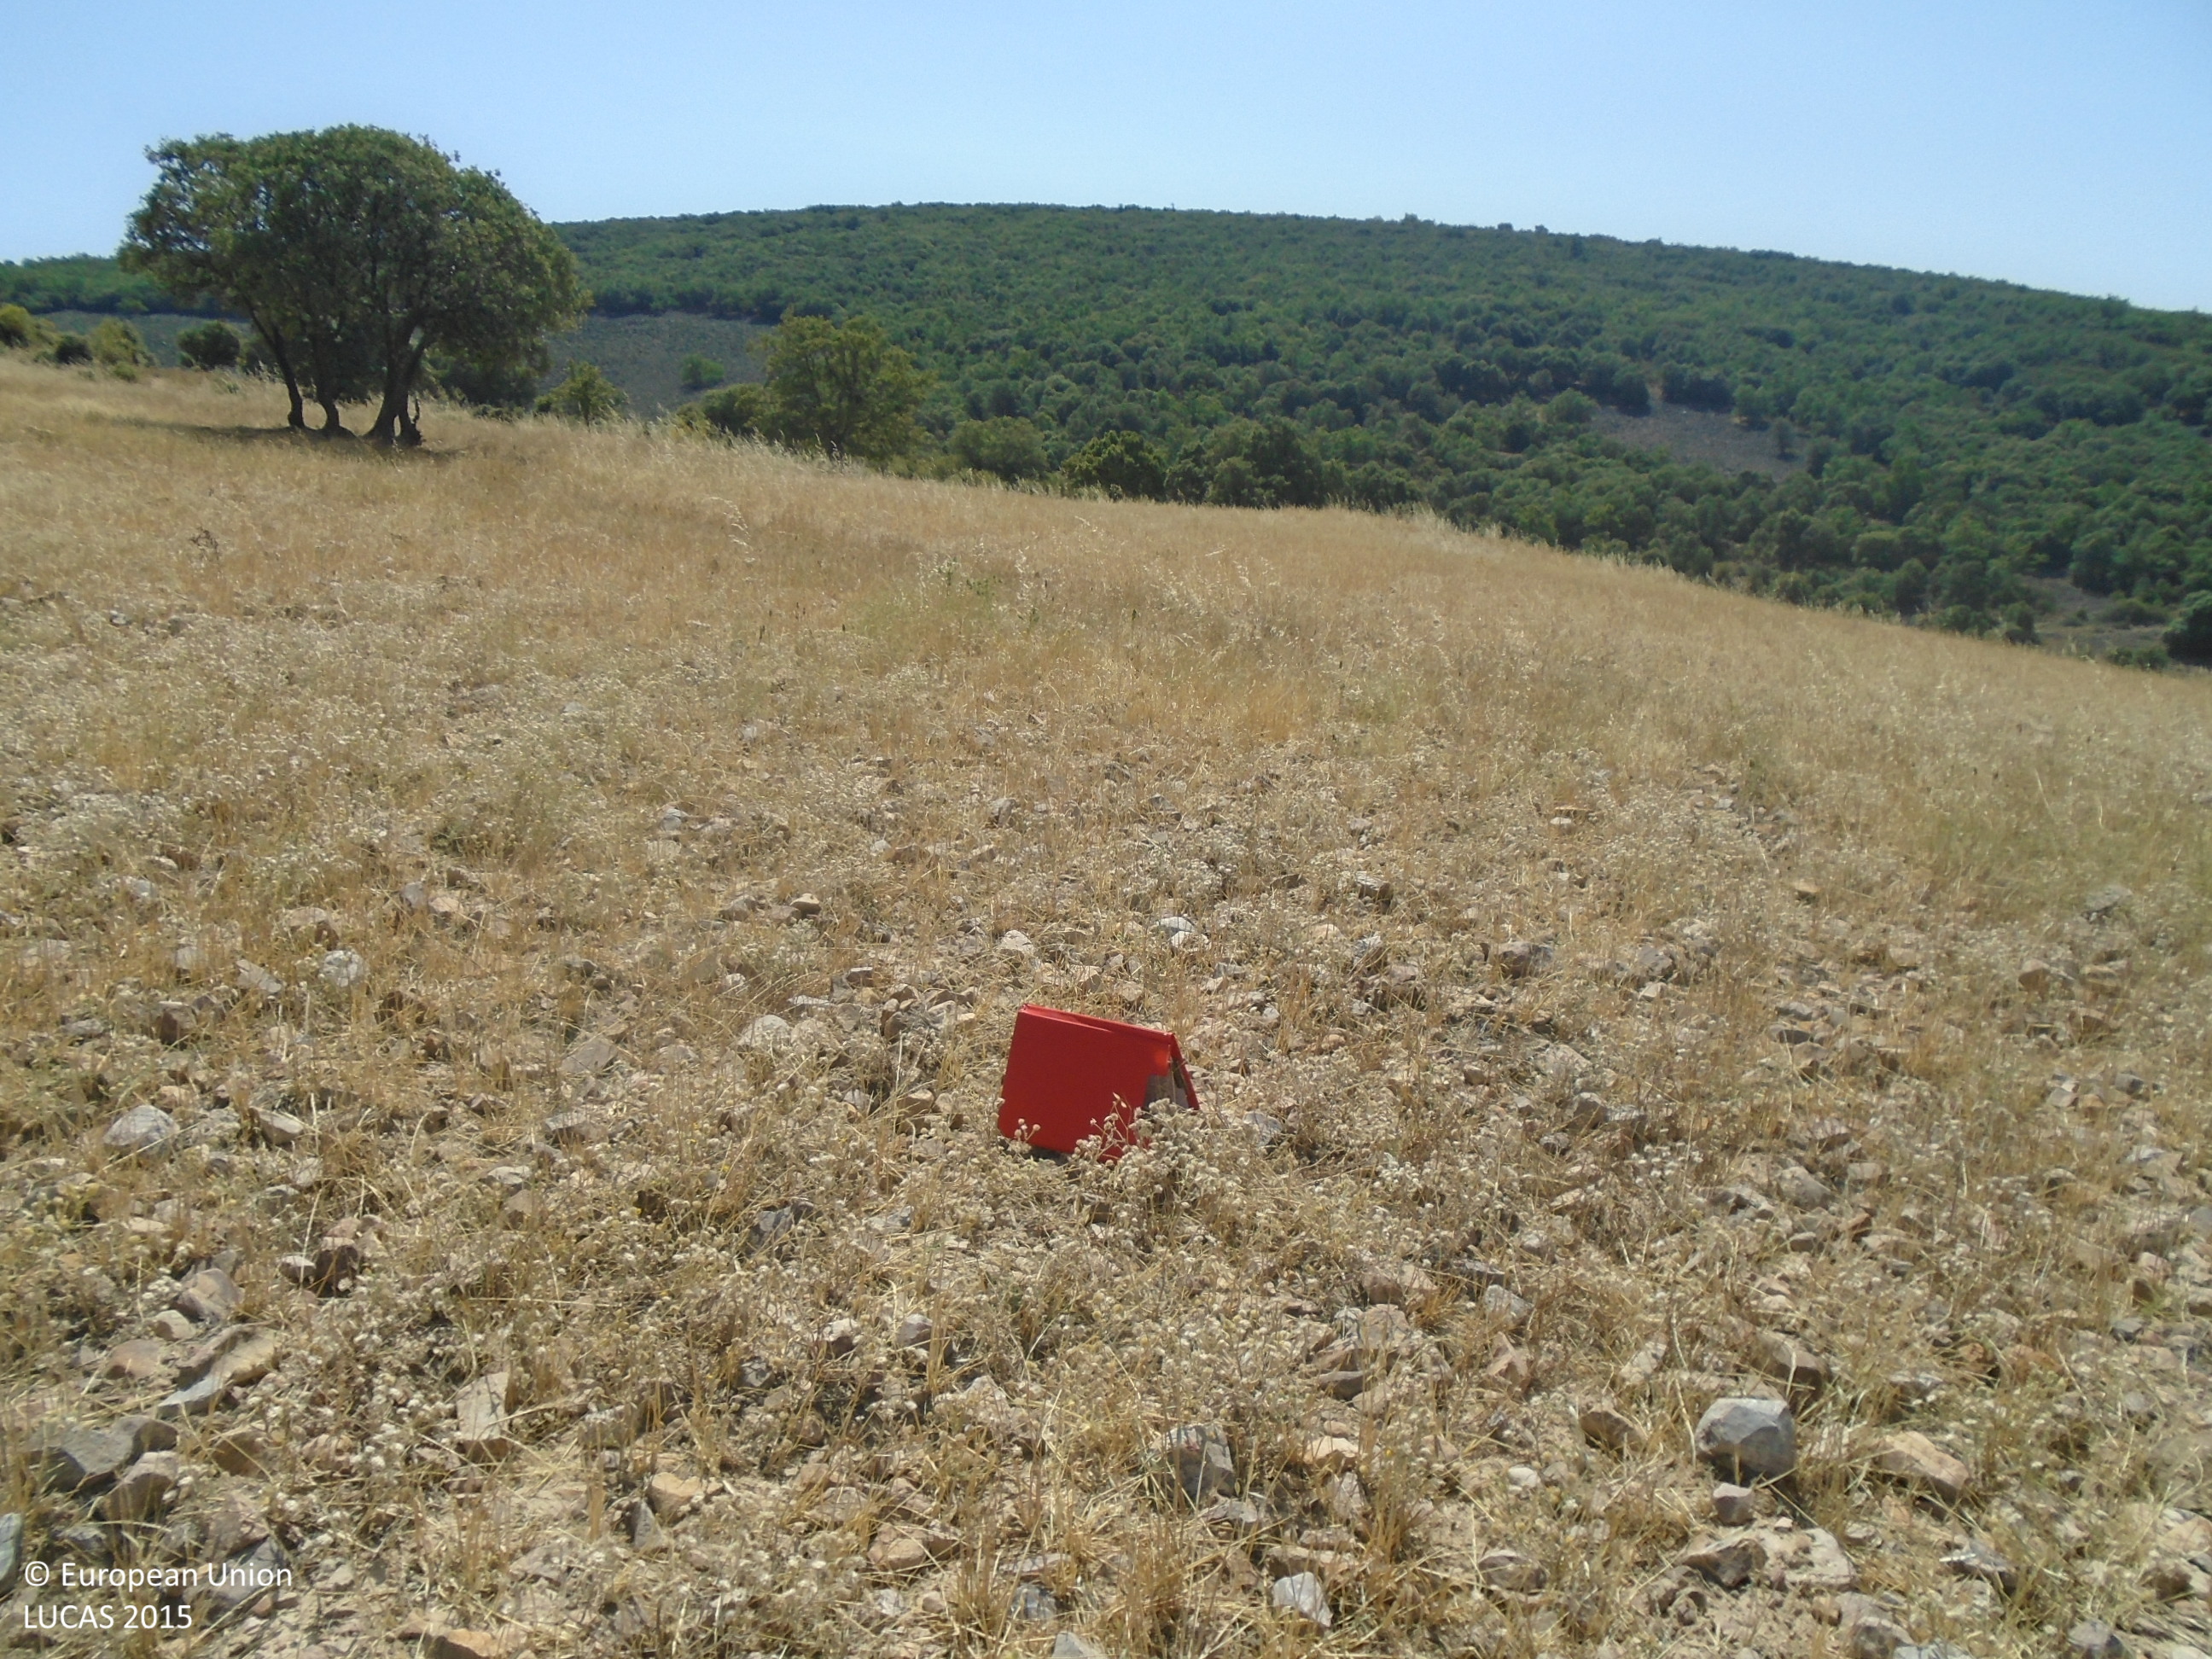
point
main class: Grassland
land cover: Spontaneously vegetated surfaces
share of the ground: > 75 %
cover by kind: herbaceous plants 80 %, consolidated bare surface 20 %
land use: Agriculture (excluding fallow land and kitchen gardens)
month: July
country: ES
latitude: 39.3383
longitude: -4.0778
